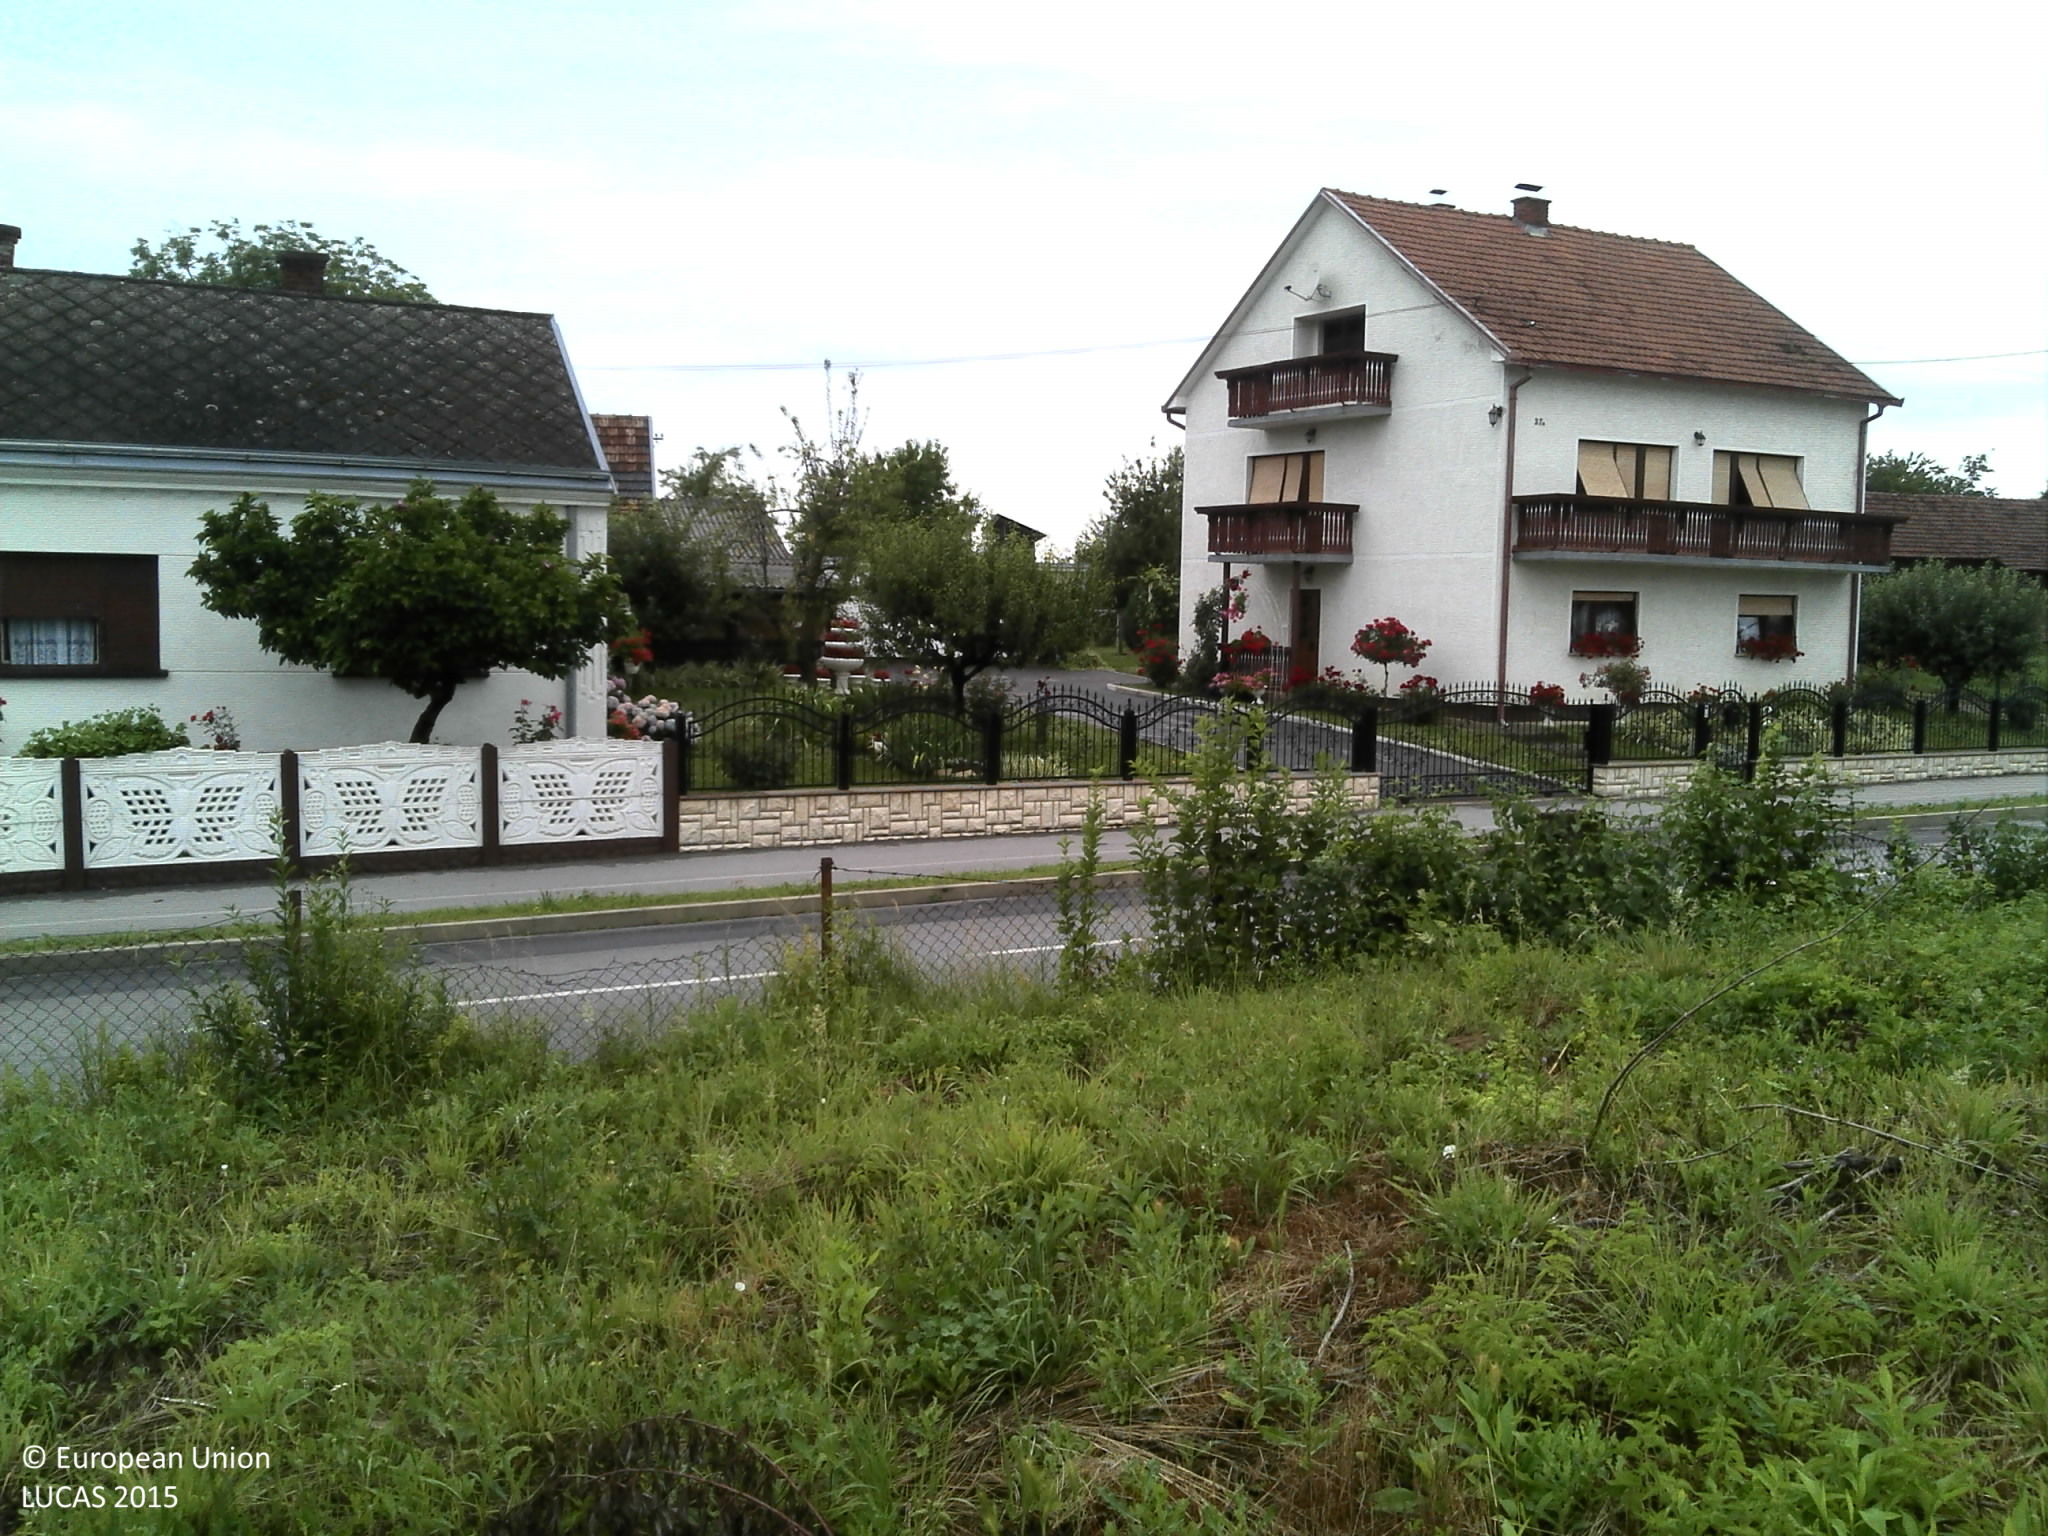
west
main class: Grassland
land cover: Spontaneously vegetated surfaces
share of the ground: > 75 %
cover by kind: herbaceous plants 100 %
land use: Abandoned areas
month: July
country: HR
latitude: 45.9148
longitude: 16.8465
